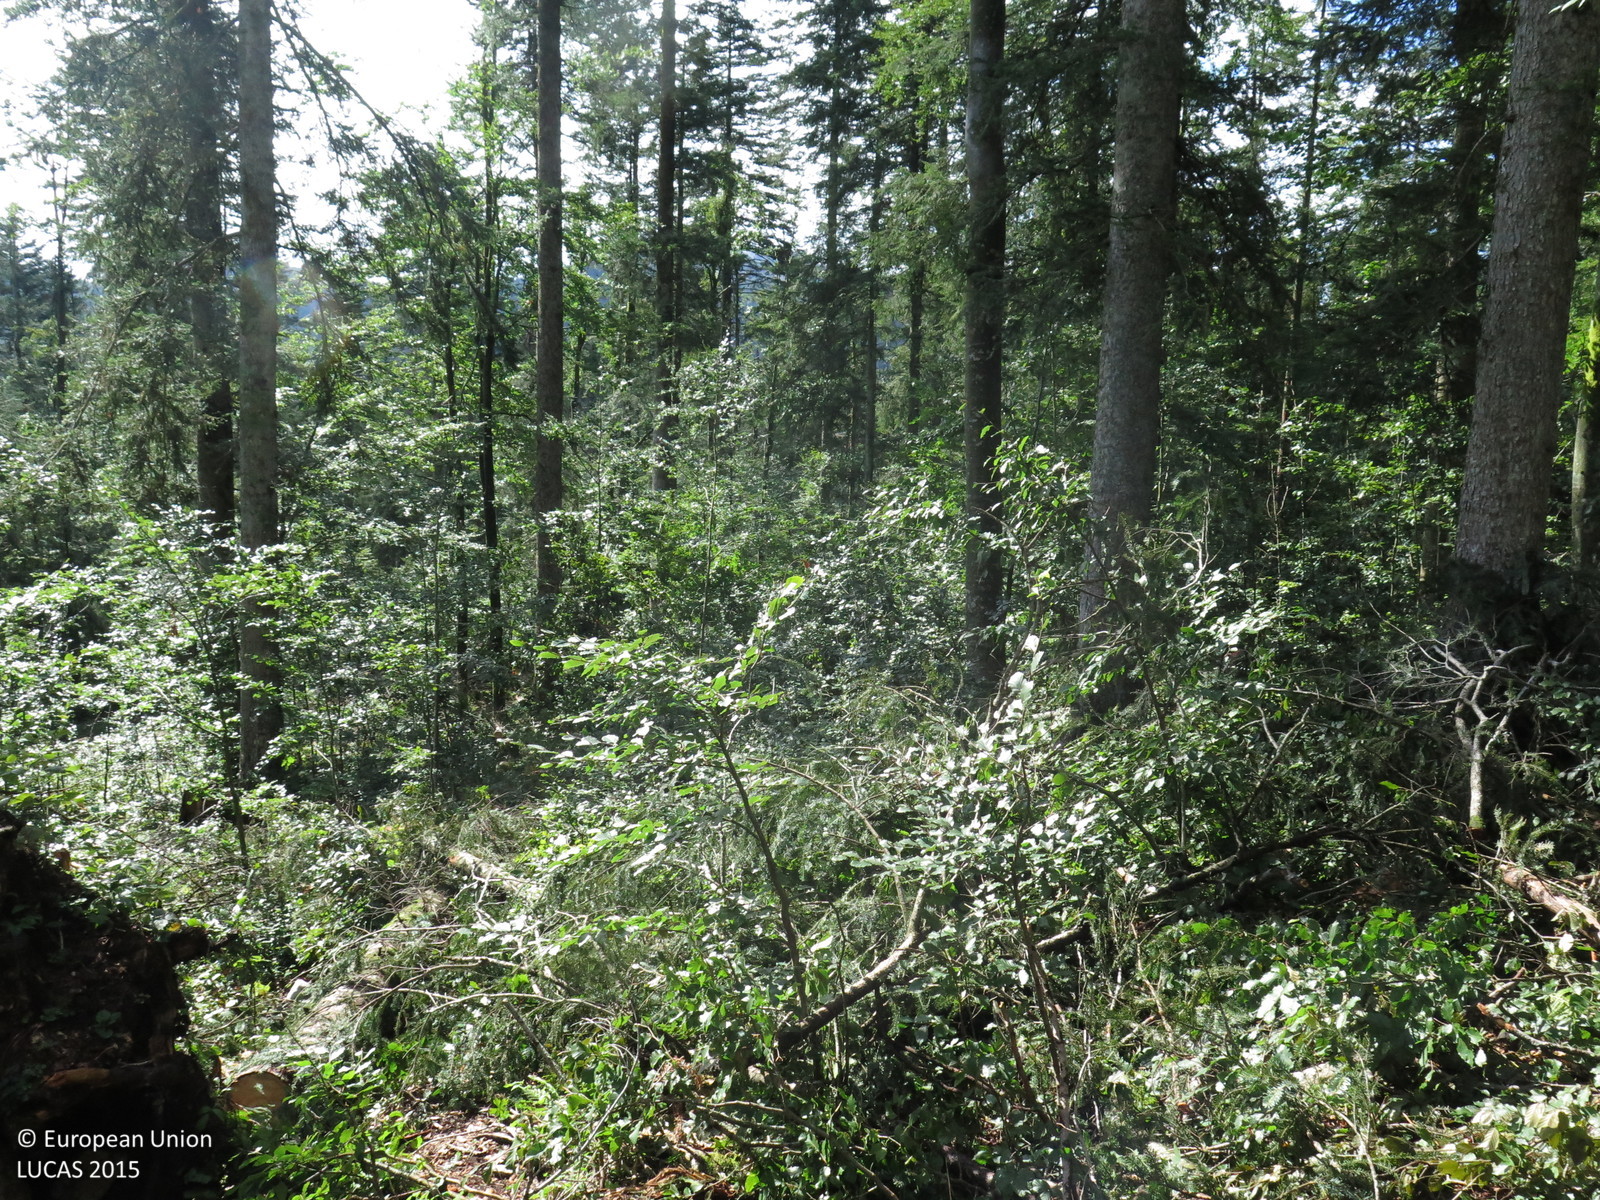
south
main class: Woodland
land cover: Other mixed woodland
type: mountainous beech forest
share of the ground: > 75 %
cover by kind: broadleaved forest trees 75 %, coniferous forest trees 25 %
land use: Forestry
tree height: > 5 m
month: September
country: HR
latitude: 45.4758
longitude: 14.6133
